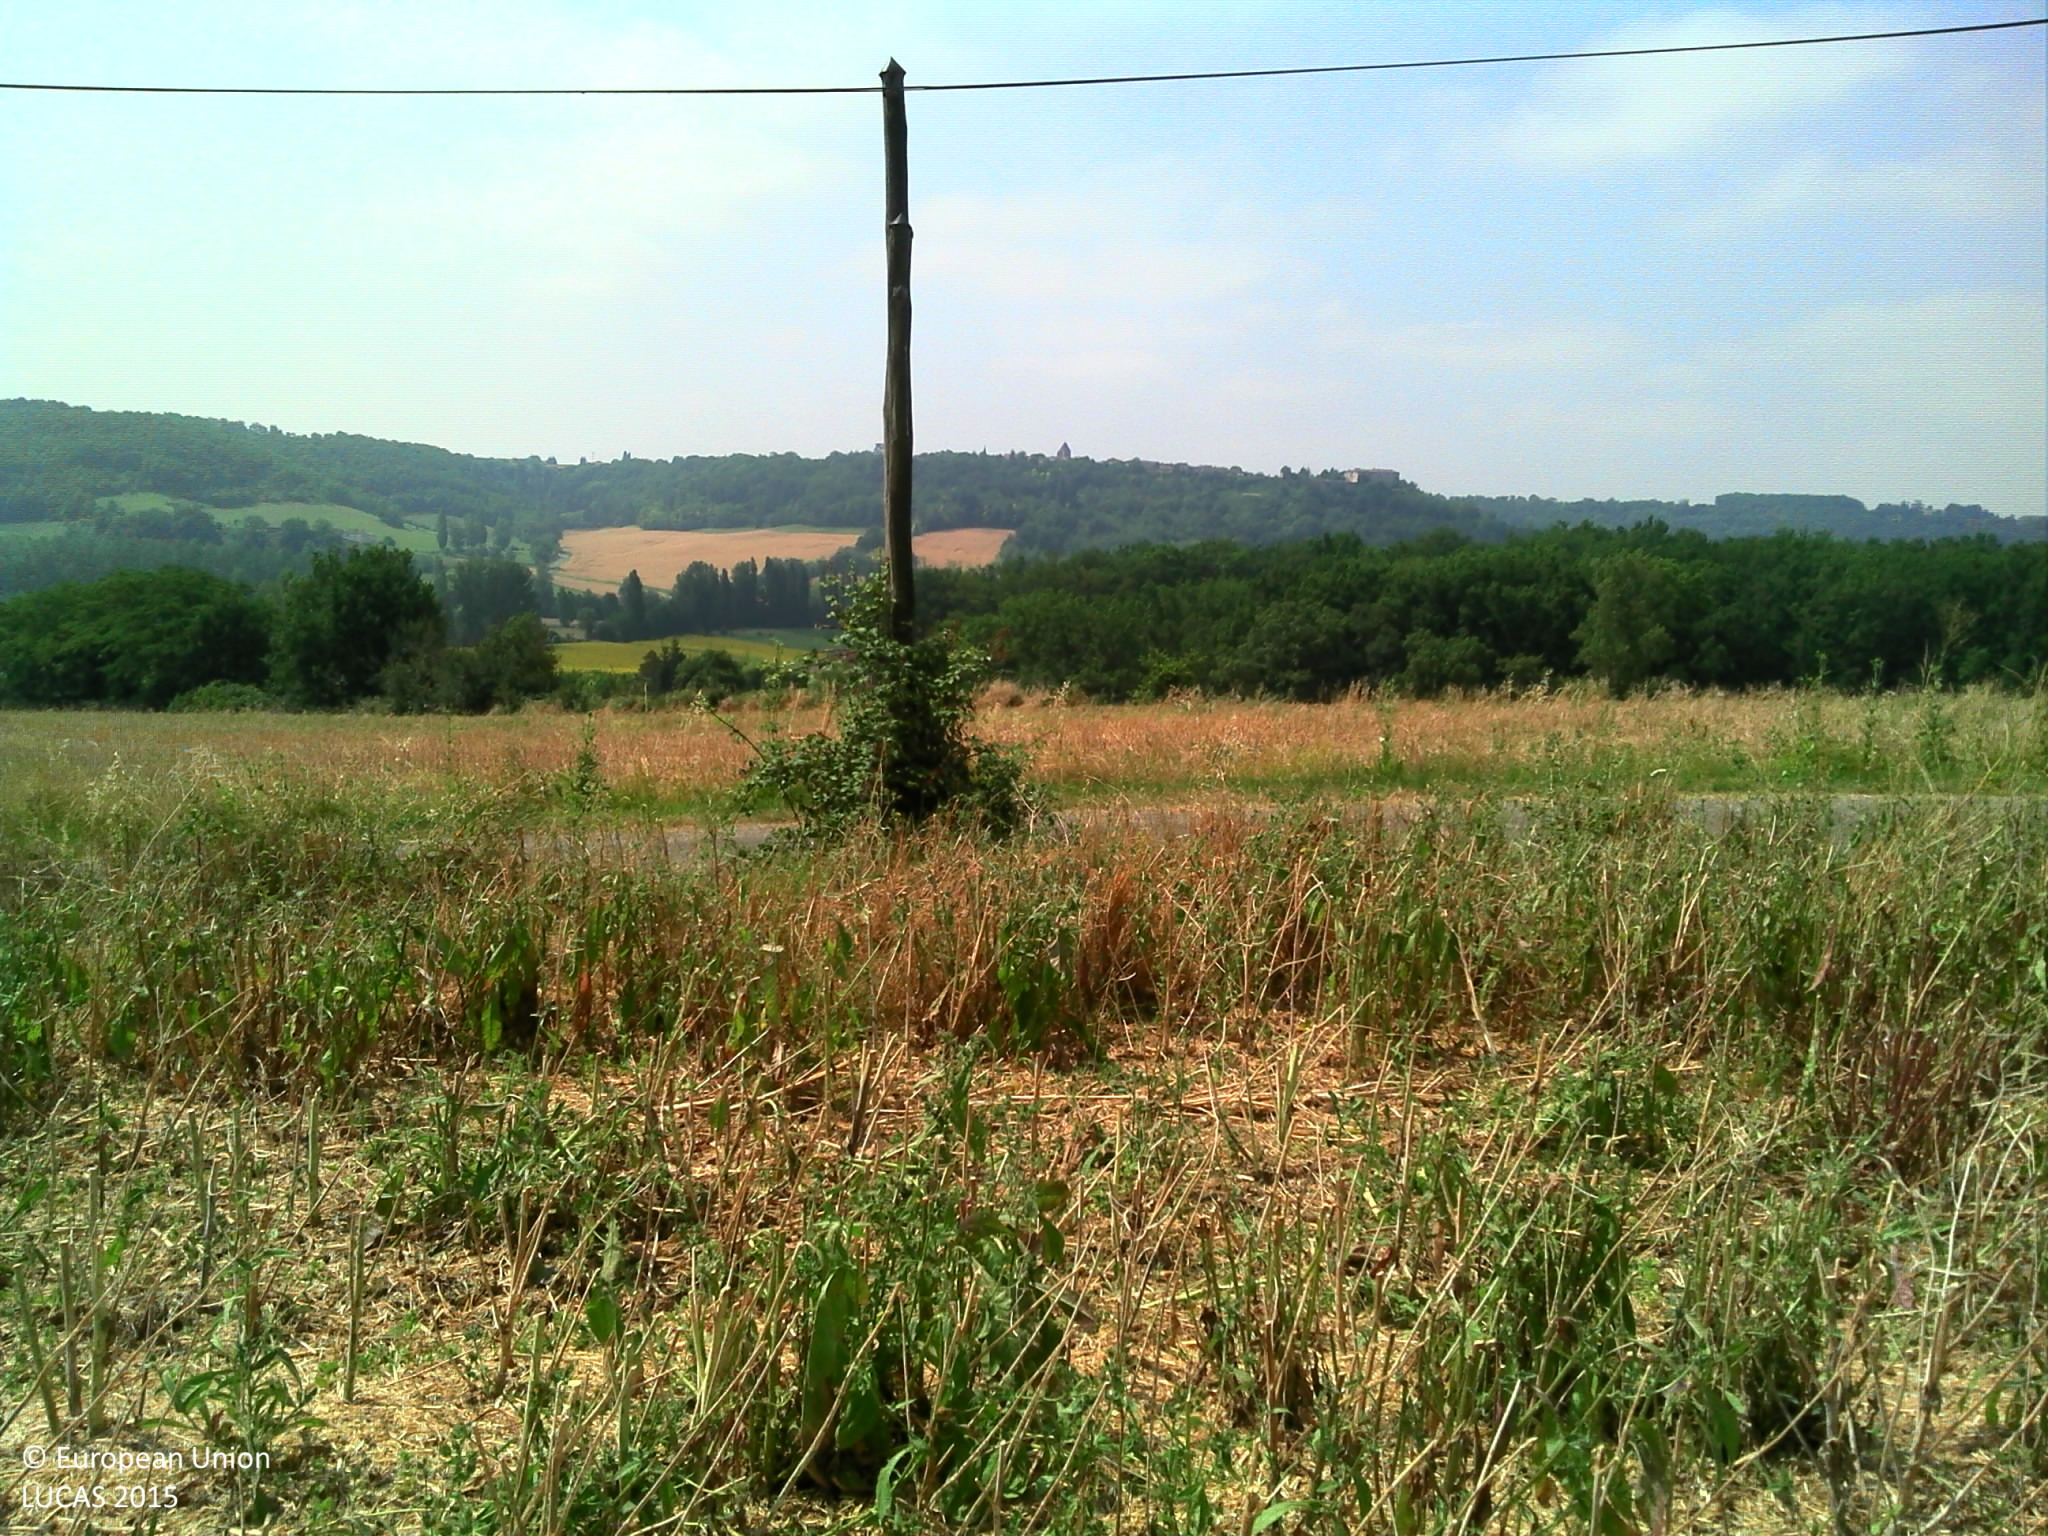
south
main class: Cropland
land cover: Rape and turnip rape
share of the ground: 10 - 25 %
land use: Agriculture (excluding fallow land and kitchen gardens)
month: July
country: FR
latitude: 44.2933
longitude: 0.8845
